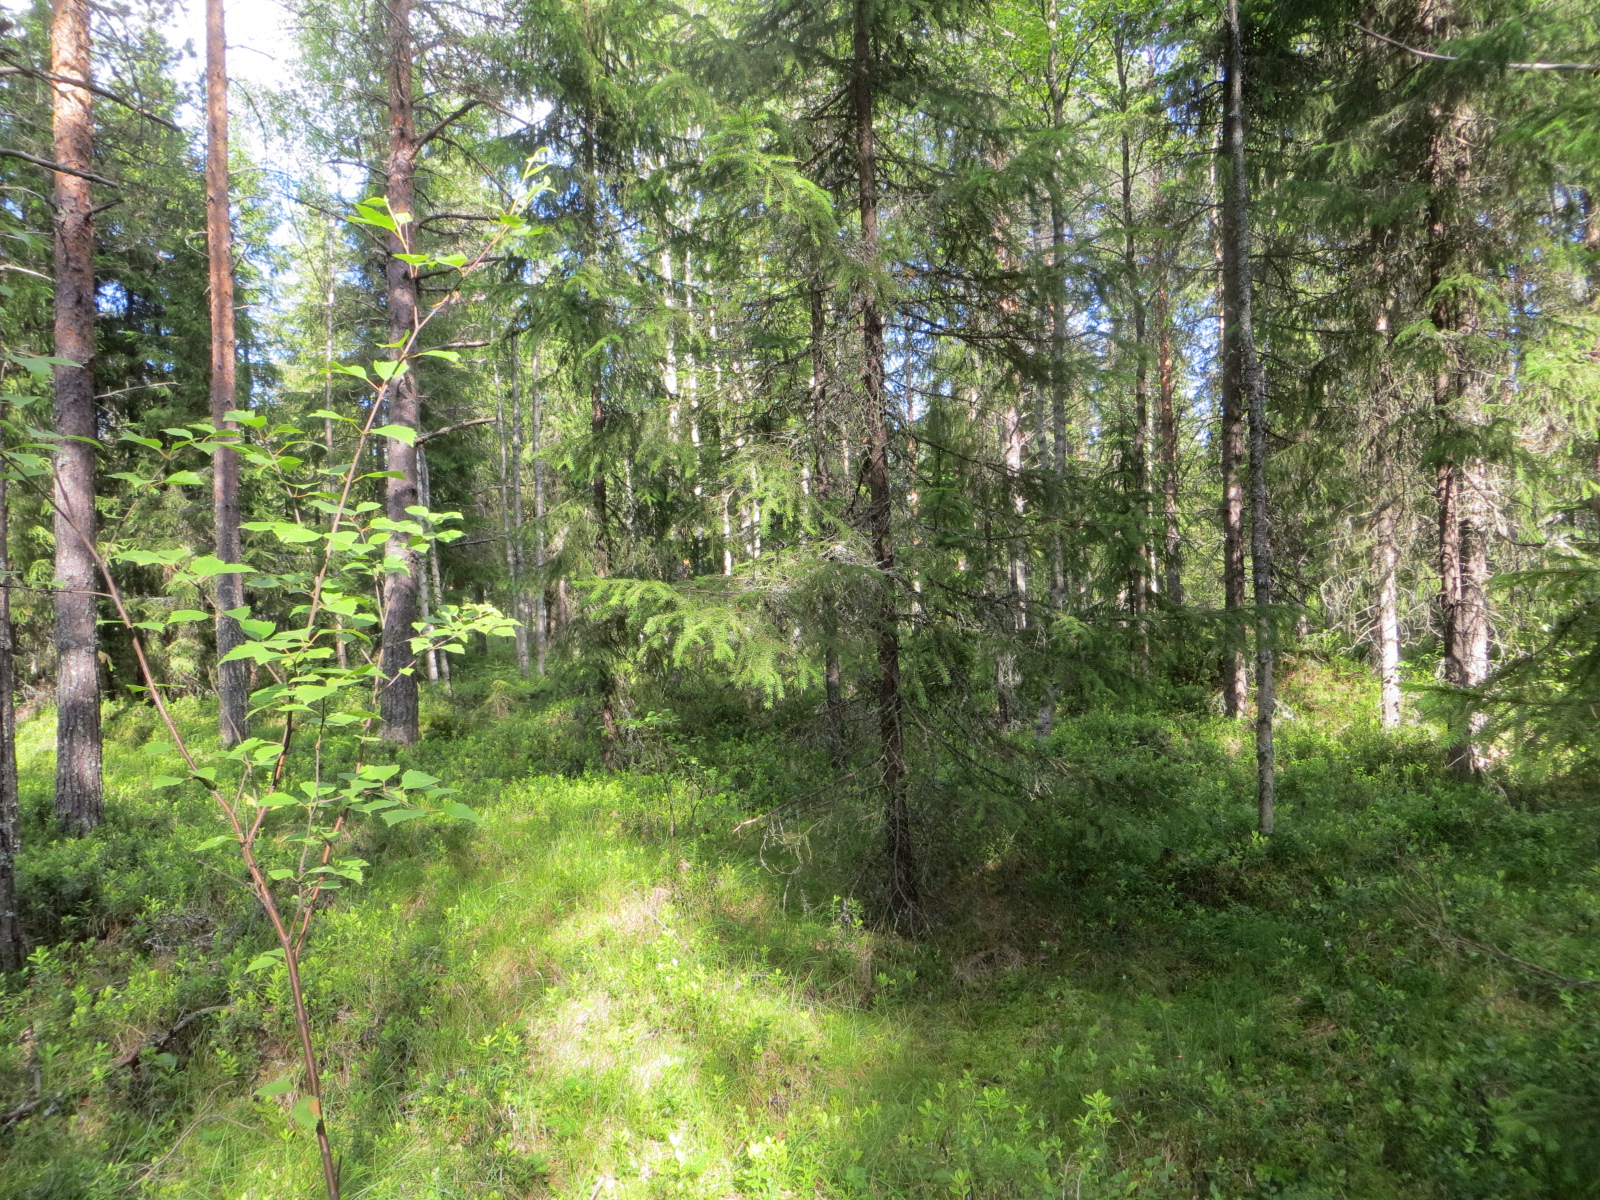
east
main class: Woodland
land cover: Other coniferous woodland
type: boreal forest
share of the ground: 50 - 75 %
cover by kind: coniferous forest trees 60 %, shrubs 40 %
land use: Forestry
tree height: > 5 m
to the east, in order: Other coniferous woodland; Ditches and canals; Broadleaved woodland; Spruce dominated coniferous woodland; Ditches and canals; Spruce dominated coniferous woodland
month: July
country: FI
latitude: 65.4549
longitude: 25.3712
